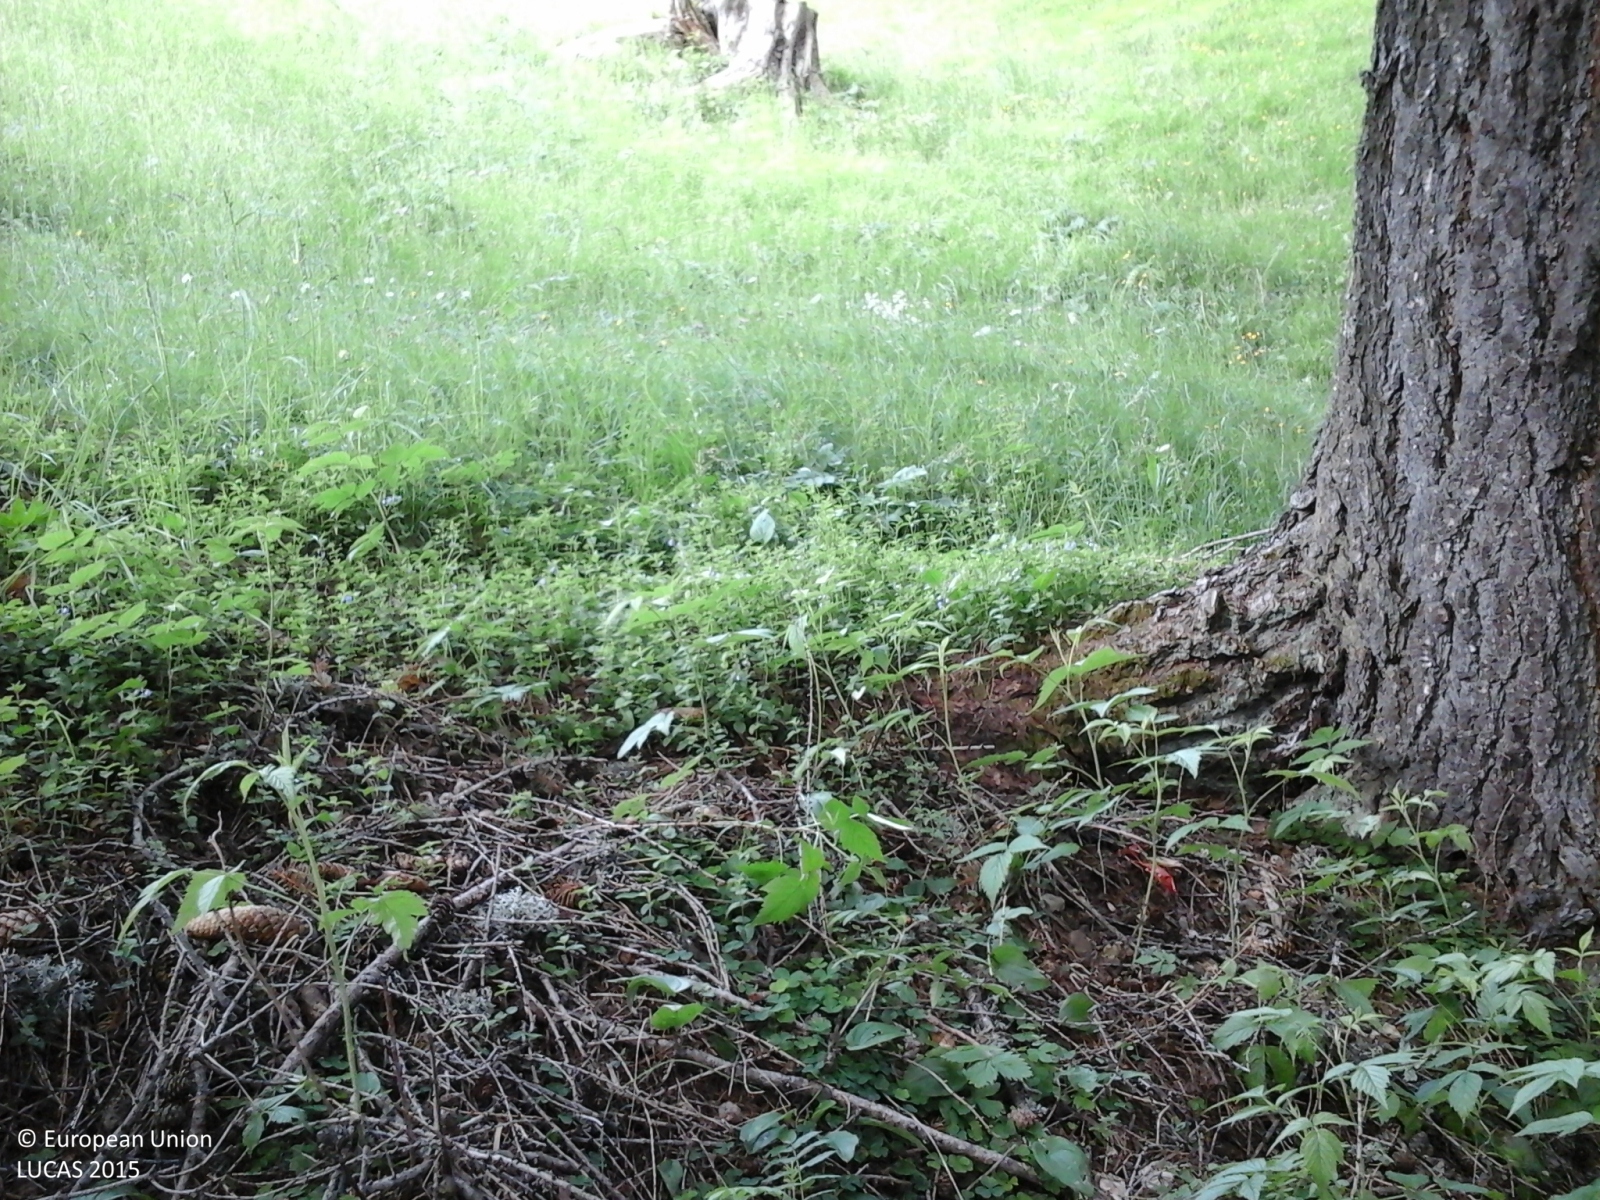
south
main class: Woodland
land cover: Spruce dominated coniferous woodland
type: alpine coniferous forest
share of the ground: > 75 %
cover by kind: coniferous forest trees 100 %
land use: Forestry
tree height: > 5 m
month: June
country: IT
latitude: 46.5529
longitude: 11.7588
